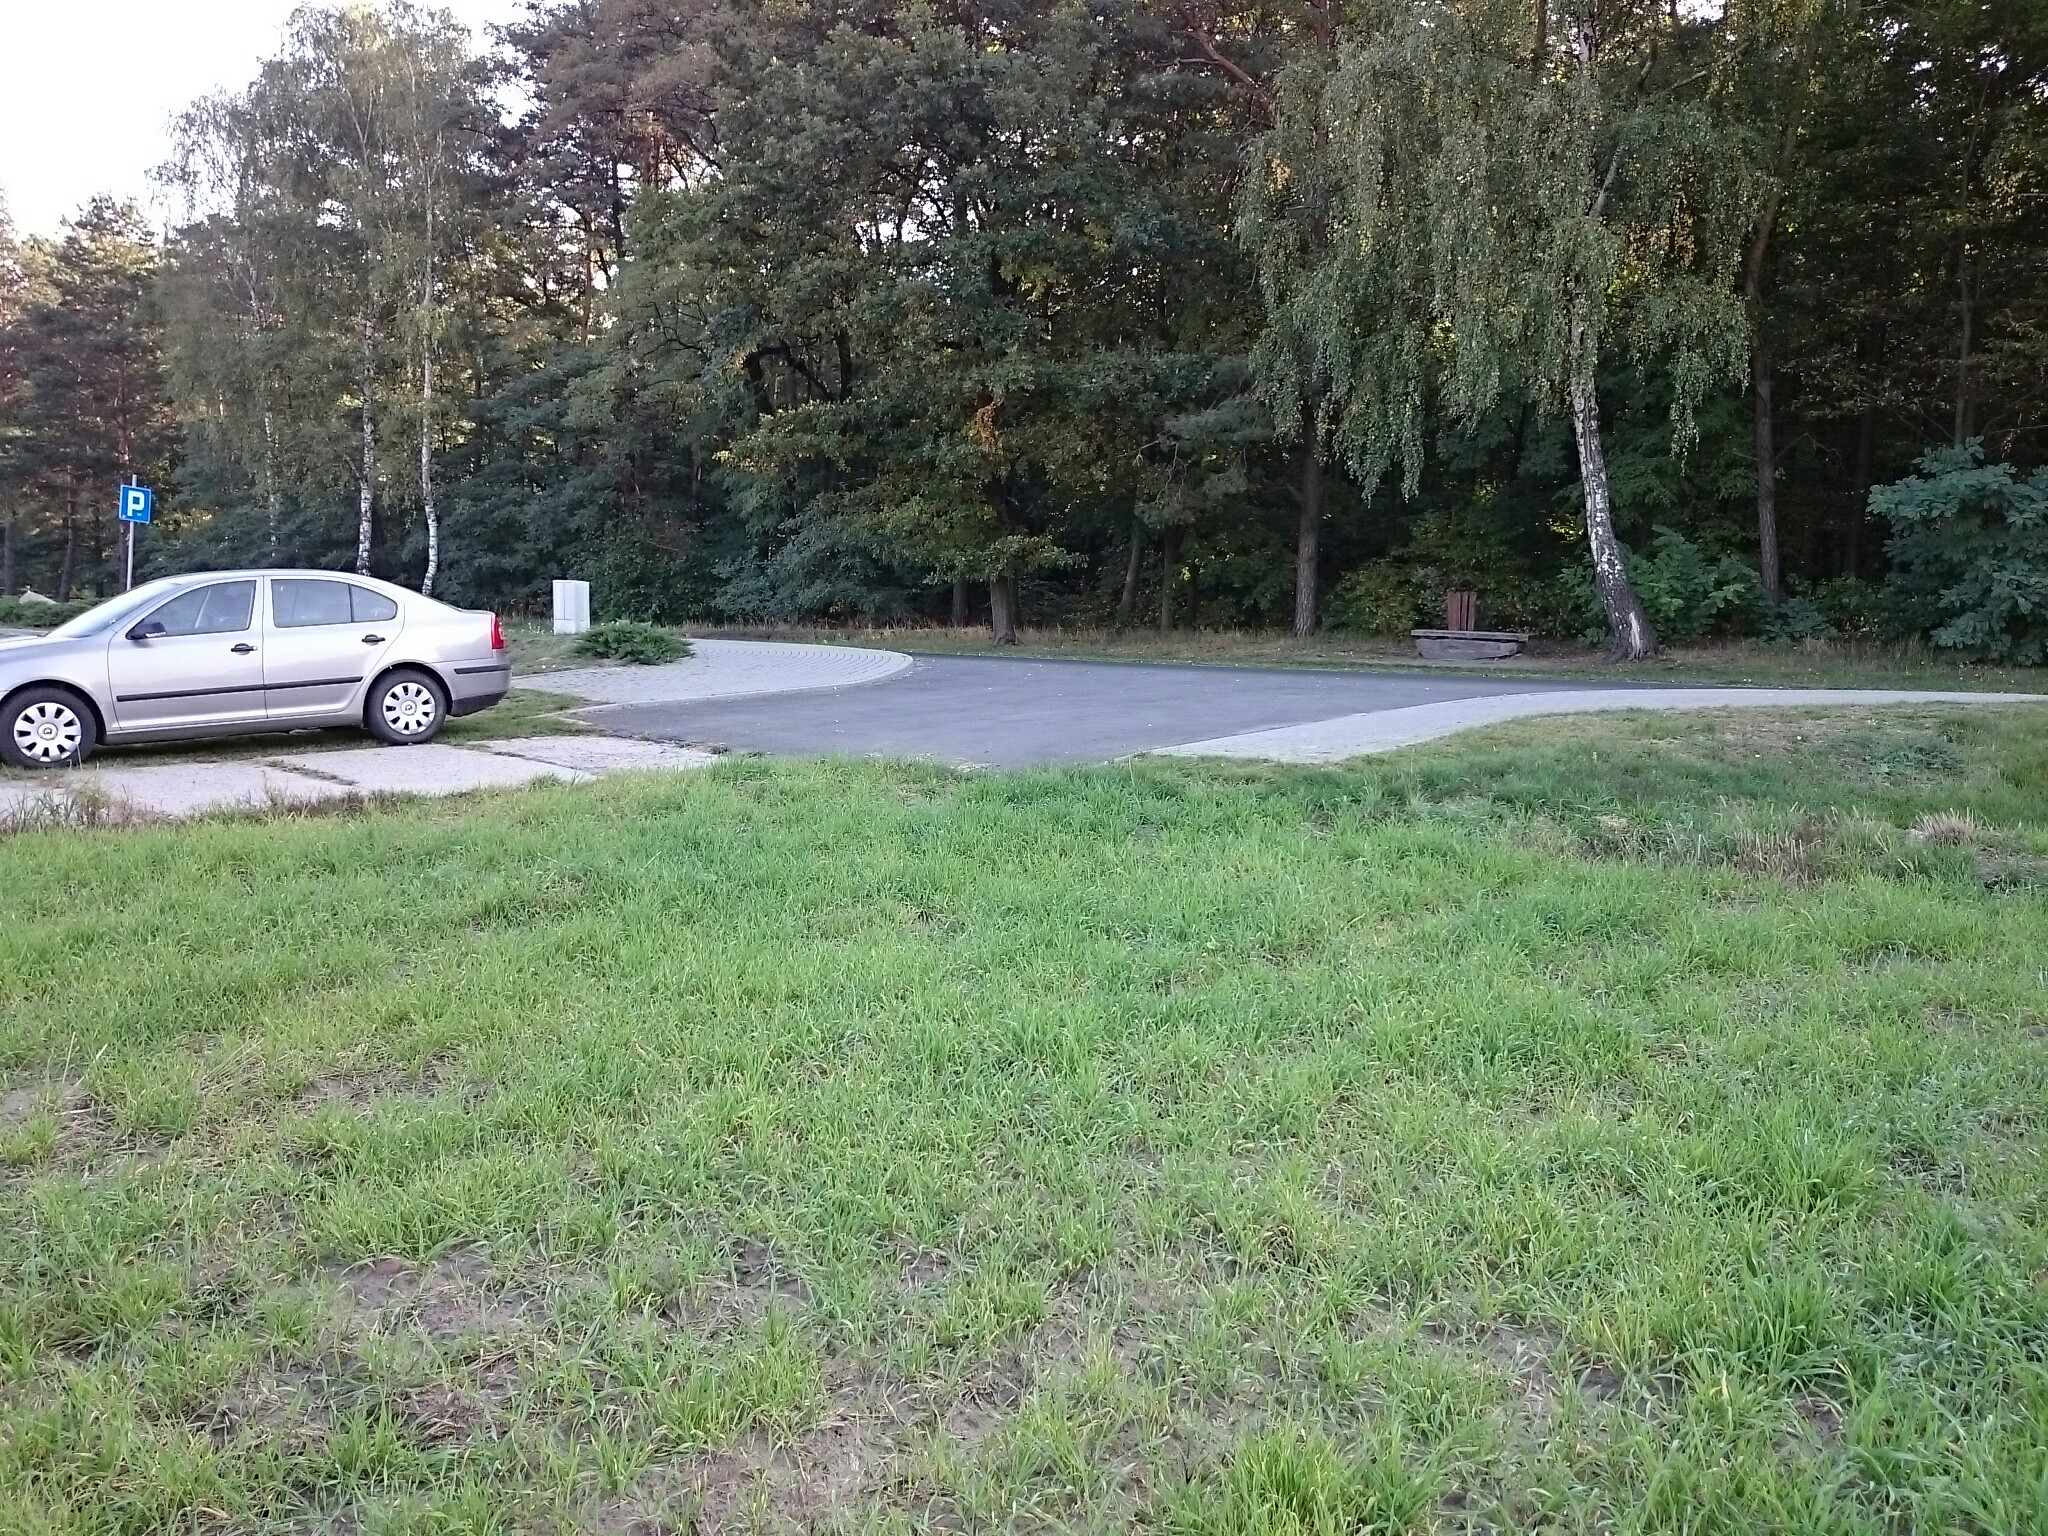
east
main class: Cropland
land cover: Temporary grasslands
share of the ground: > 75 %
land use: Agriculture (excluding fallow land and kitchen gardens)
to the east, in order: Temporary grasslands; Paved roads, cycling and walking lanes; Grass margins; Pine dominated mixed woodland; Tracks; Pine dominated mixed woodland
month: September
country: PL
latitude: 51.6251
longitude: 17.3646
